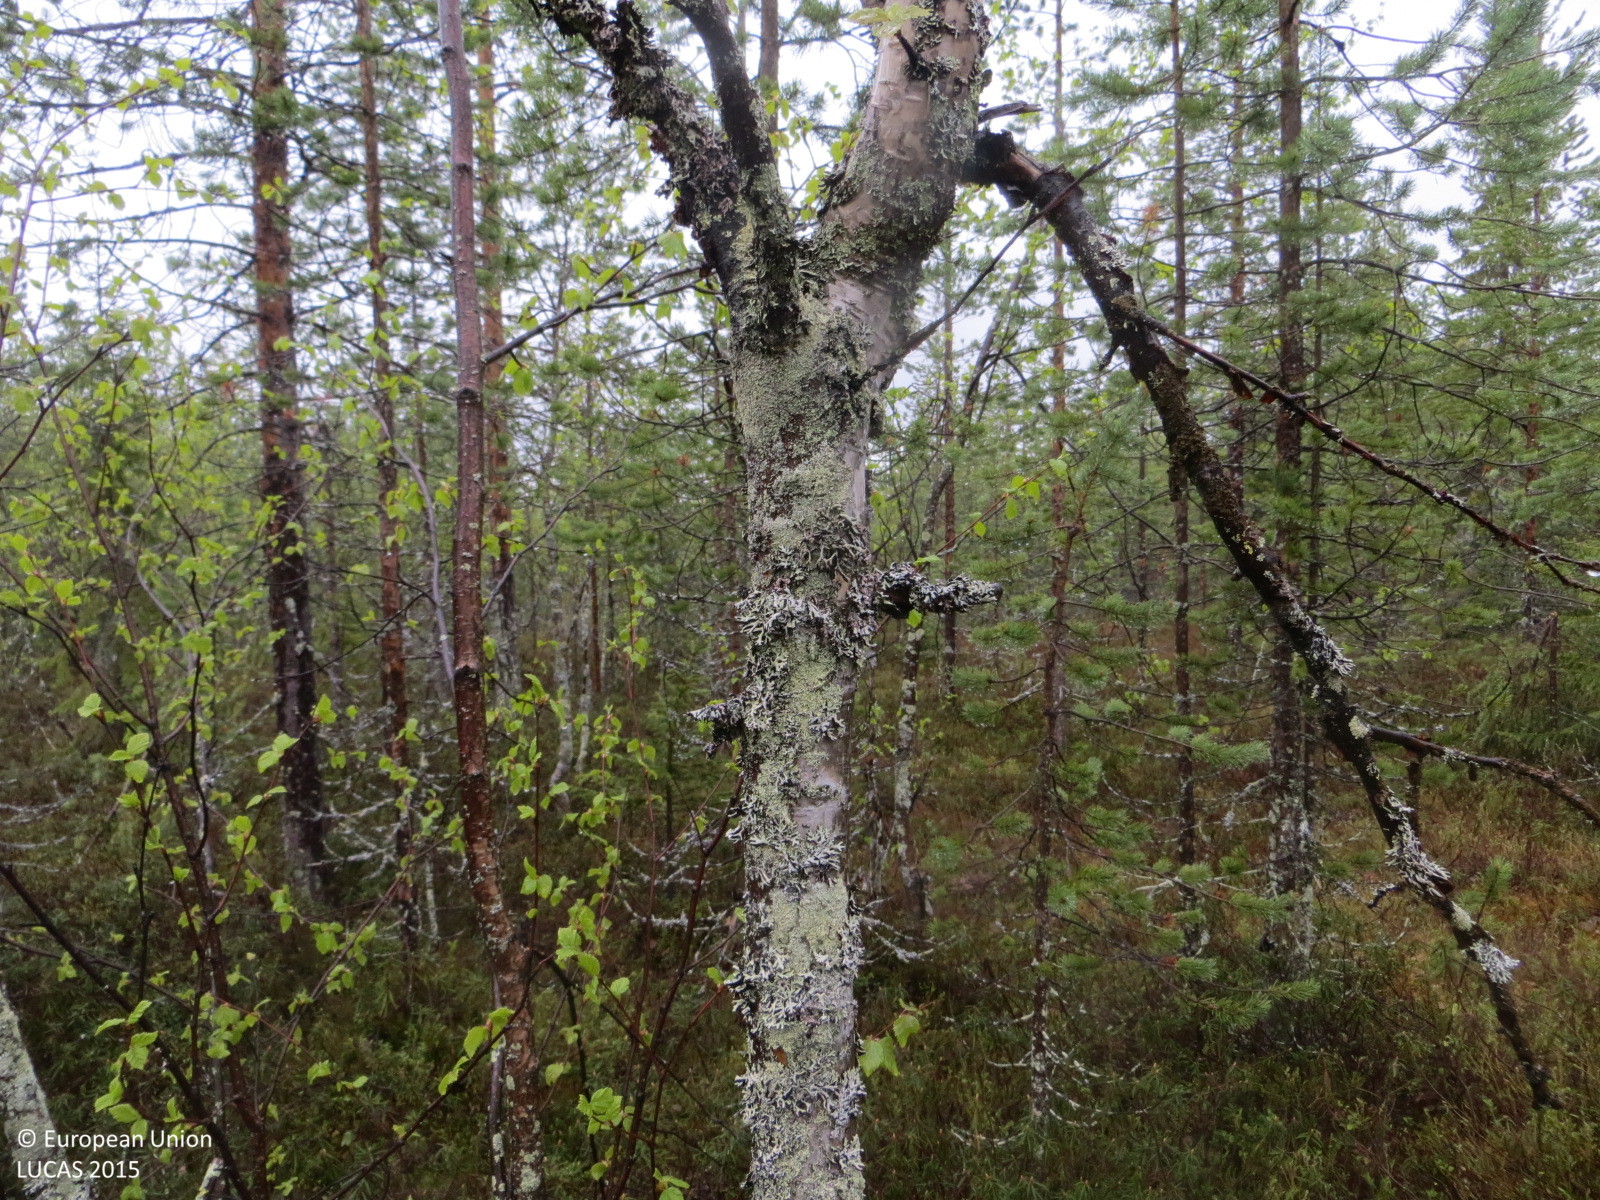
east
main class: Woodland
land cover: Other mixed woodland
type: boreal forest
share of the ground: > 75 %
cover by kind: coniferous forest trees 50 %, broadleaved forest trees 30 %, shrubs 20 %
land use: Forestry
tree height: > 5 m
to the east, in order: Other mixed woodland; Rivers and streams; Shrubland without tree cover; Paved roads, cycling and walking lanes; Shrubland without tree cover; Pine dominated mixed woodland; Ditches and canals; Pine dominated mixed woodland; Pine dominated coniferous woodland
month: June
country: FI
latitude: 66.8779
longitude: 25.4147
